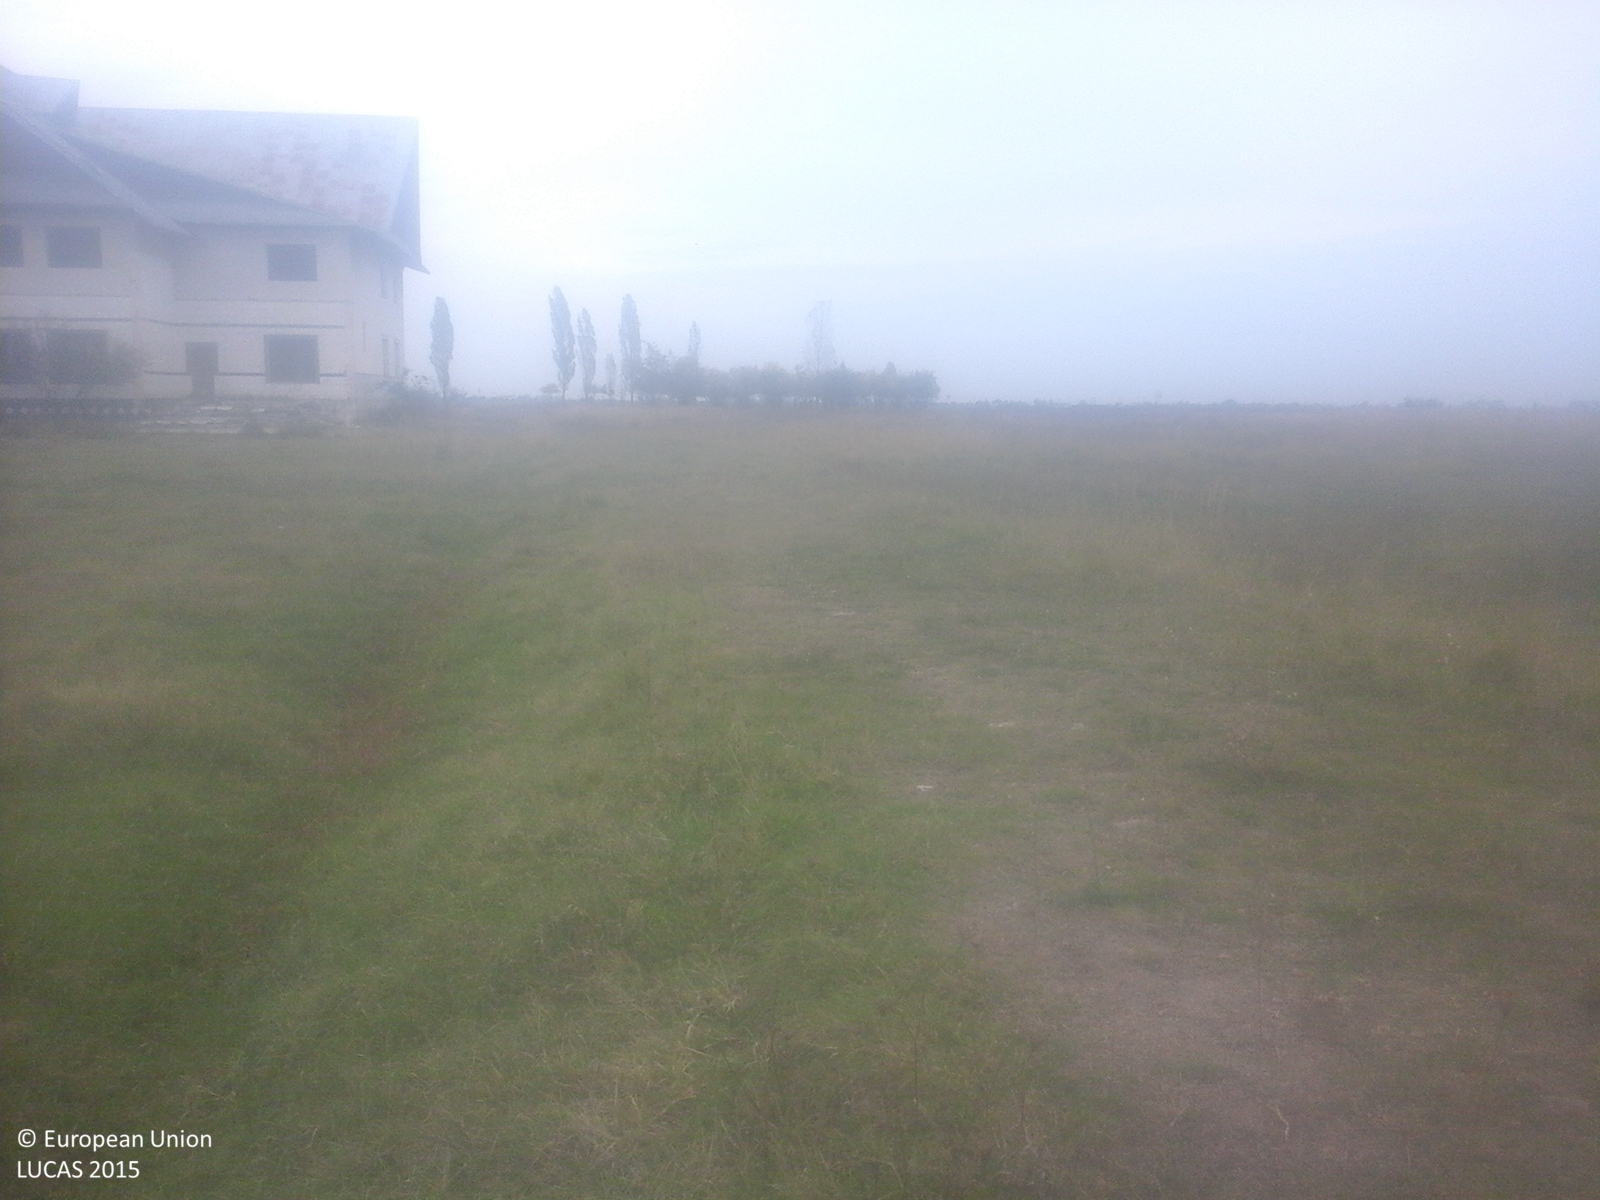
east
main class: Artificial land
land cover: Non built-up linear features
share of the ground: > 75 %
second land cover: Grassland without tree/shrub cover
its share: > 75 %
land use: Road transport
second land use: Residential
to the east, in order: Grass margins; Tracks; Grassland without tree/shrub cover; Spontaneously vegetated surfaces; Grassland without tree/shrub cover; Broadleaved woodland; Sunflower
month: October
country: RO
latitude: 44.9716
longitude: 25.7616
